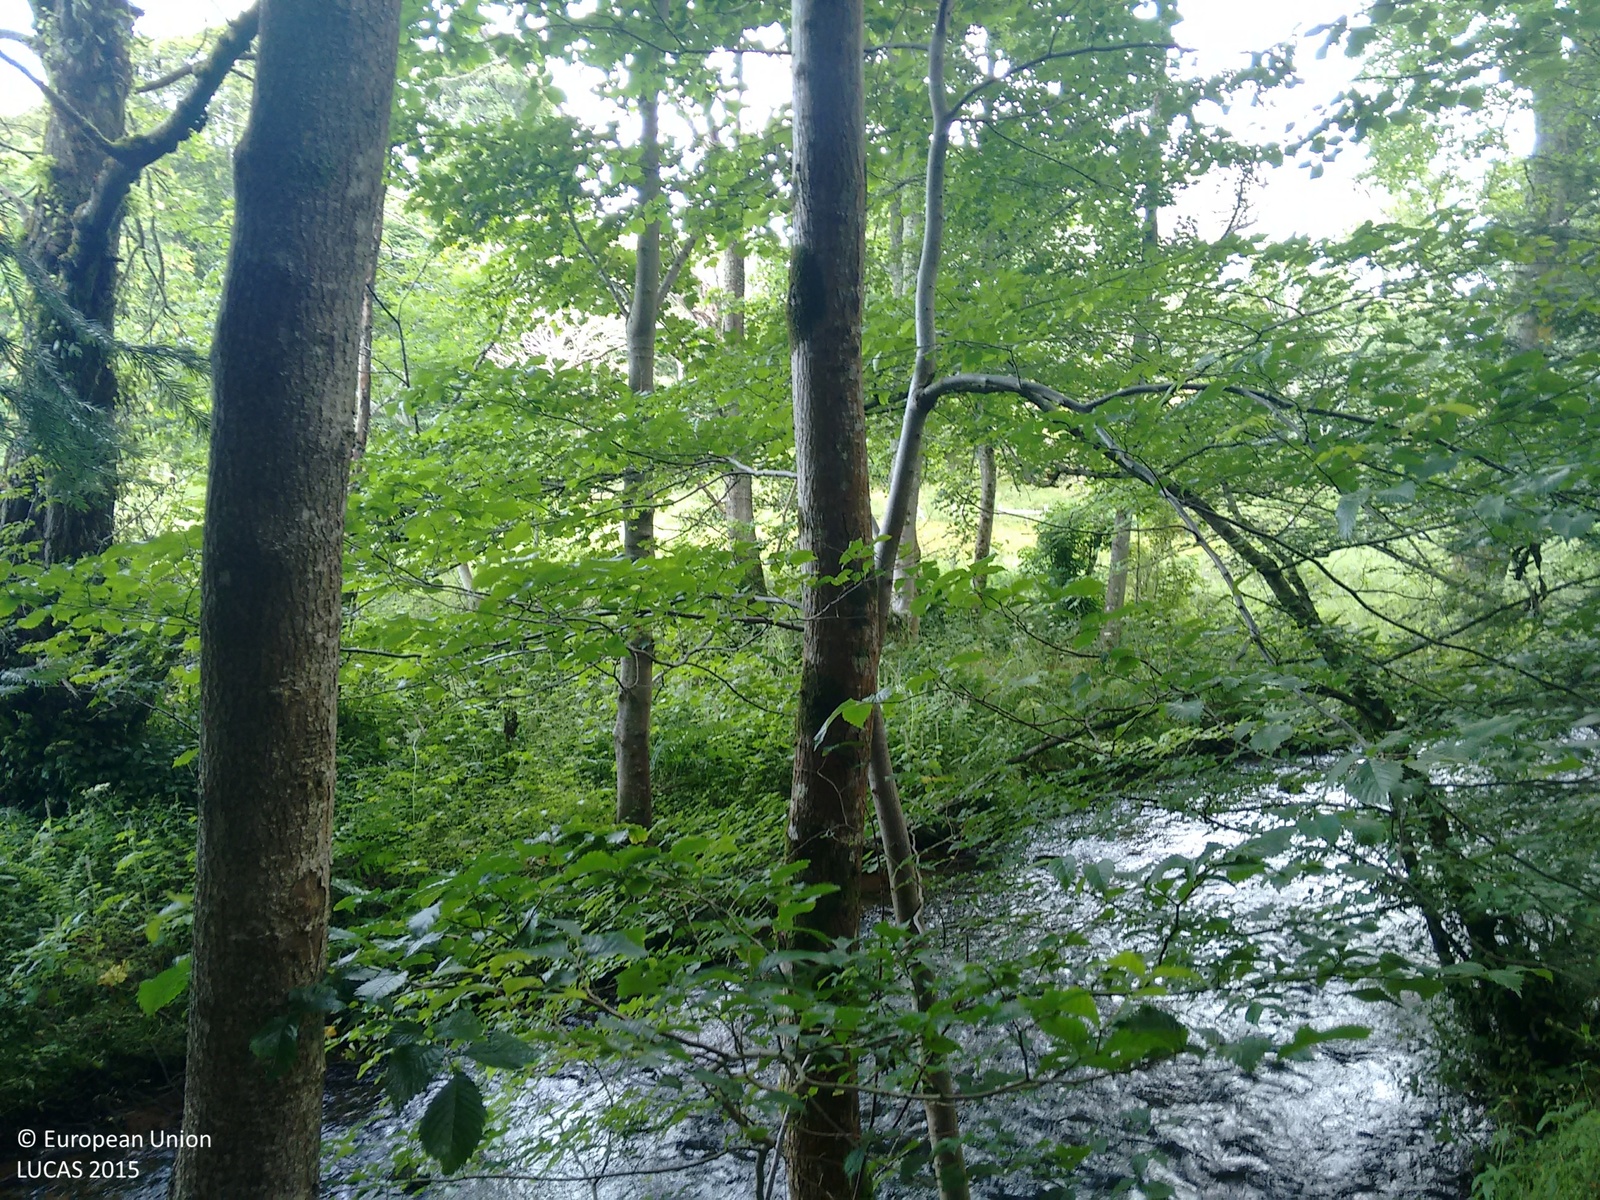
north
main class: Woodland
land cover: Broadleaved woodland
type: floodplain forest
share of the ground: > 75 %
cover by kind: broadleaved forest trees 95 %, coniferous forest trees 5 %
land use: Semi-natural and natural areas not in use
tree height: > 5 m
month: August
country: GB
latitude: 57.5686
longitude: -4.2116
